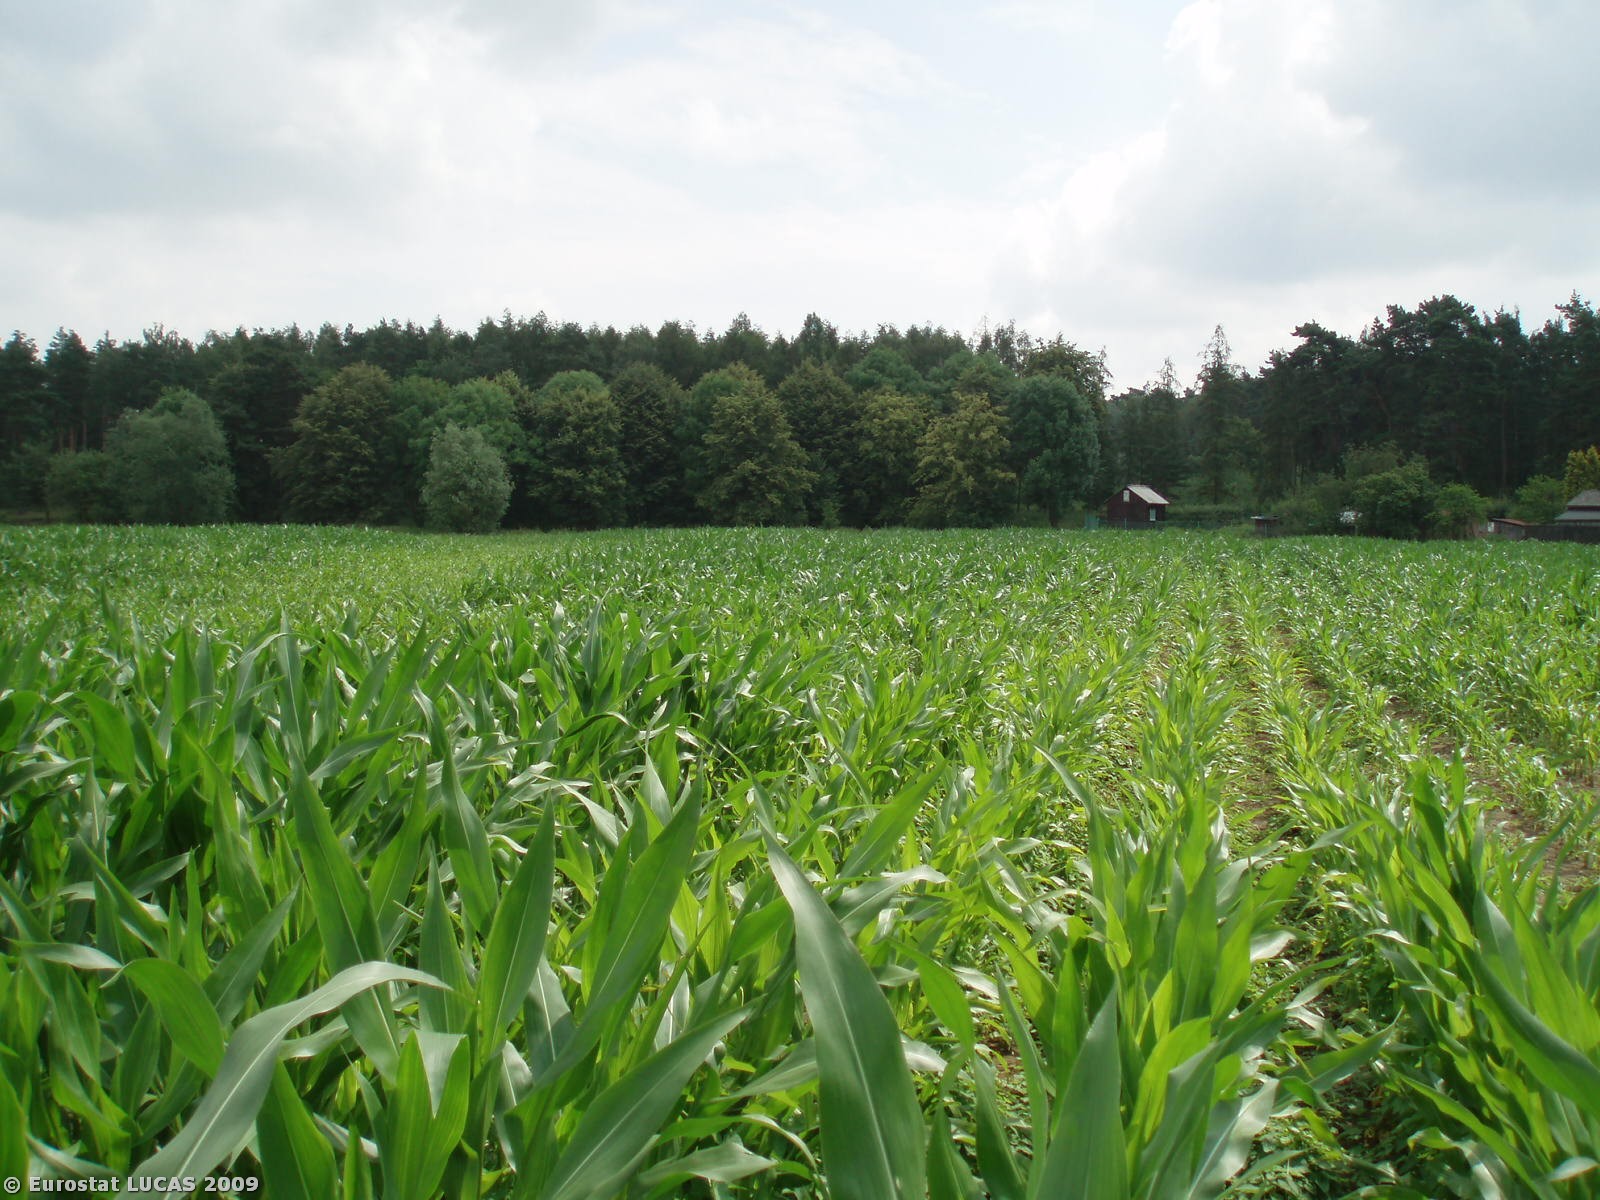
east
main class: Cropland
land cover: Maize
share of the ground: > 75 %
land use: Agriculture (excluding fallow land and kitchen gardens)
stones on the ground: < 10 %
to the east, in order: Maize; Shruby margins; Rivers and streams; Broadleaved woodland; Tracks; Coniferous woodland; Mixed woodland; Tracks; Fences; Broadleaved woodland
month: June
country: CZ
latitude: 49.7073
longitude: 13.2032
